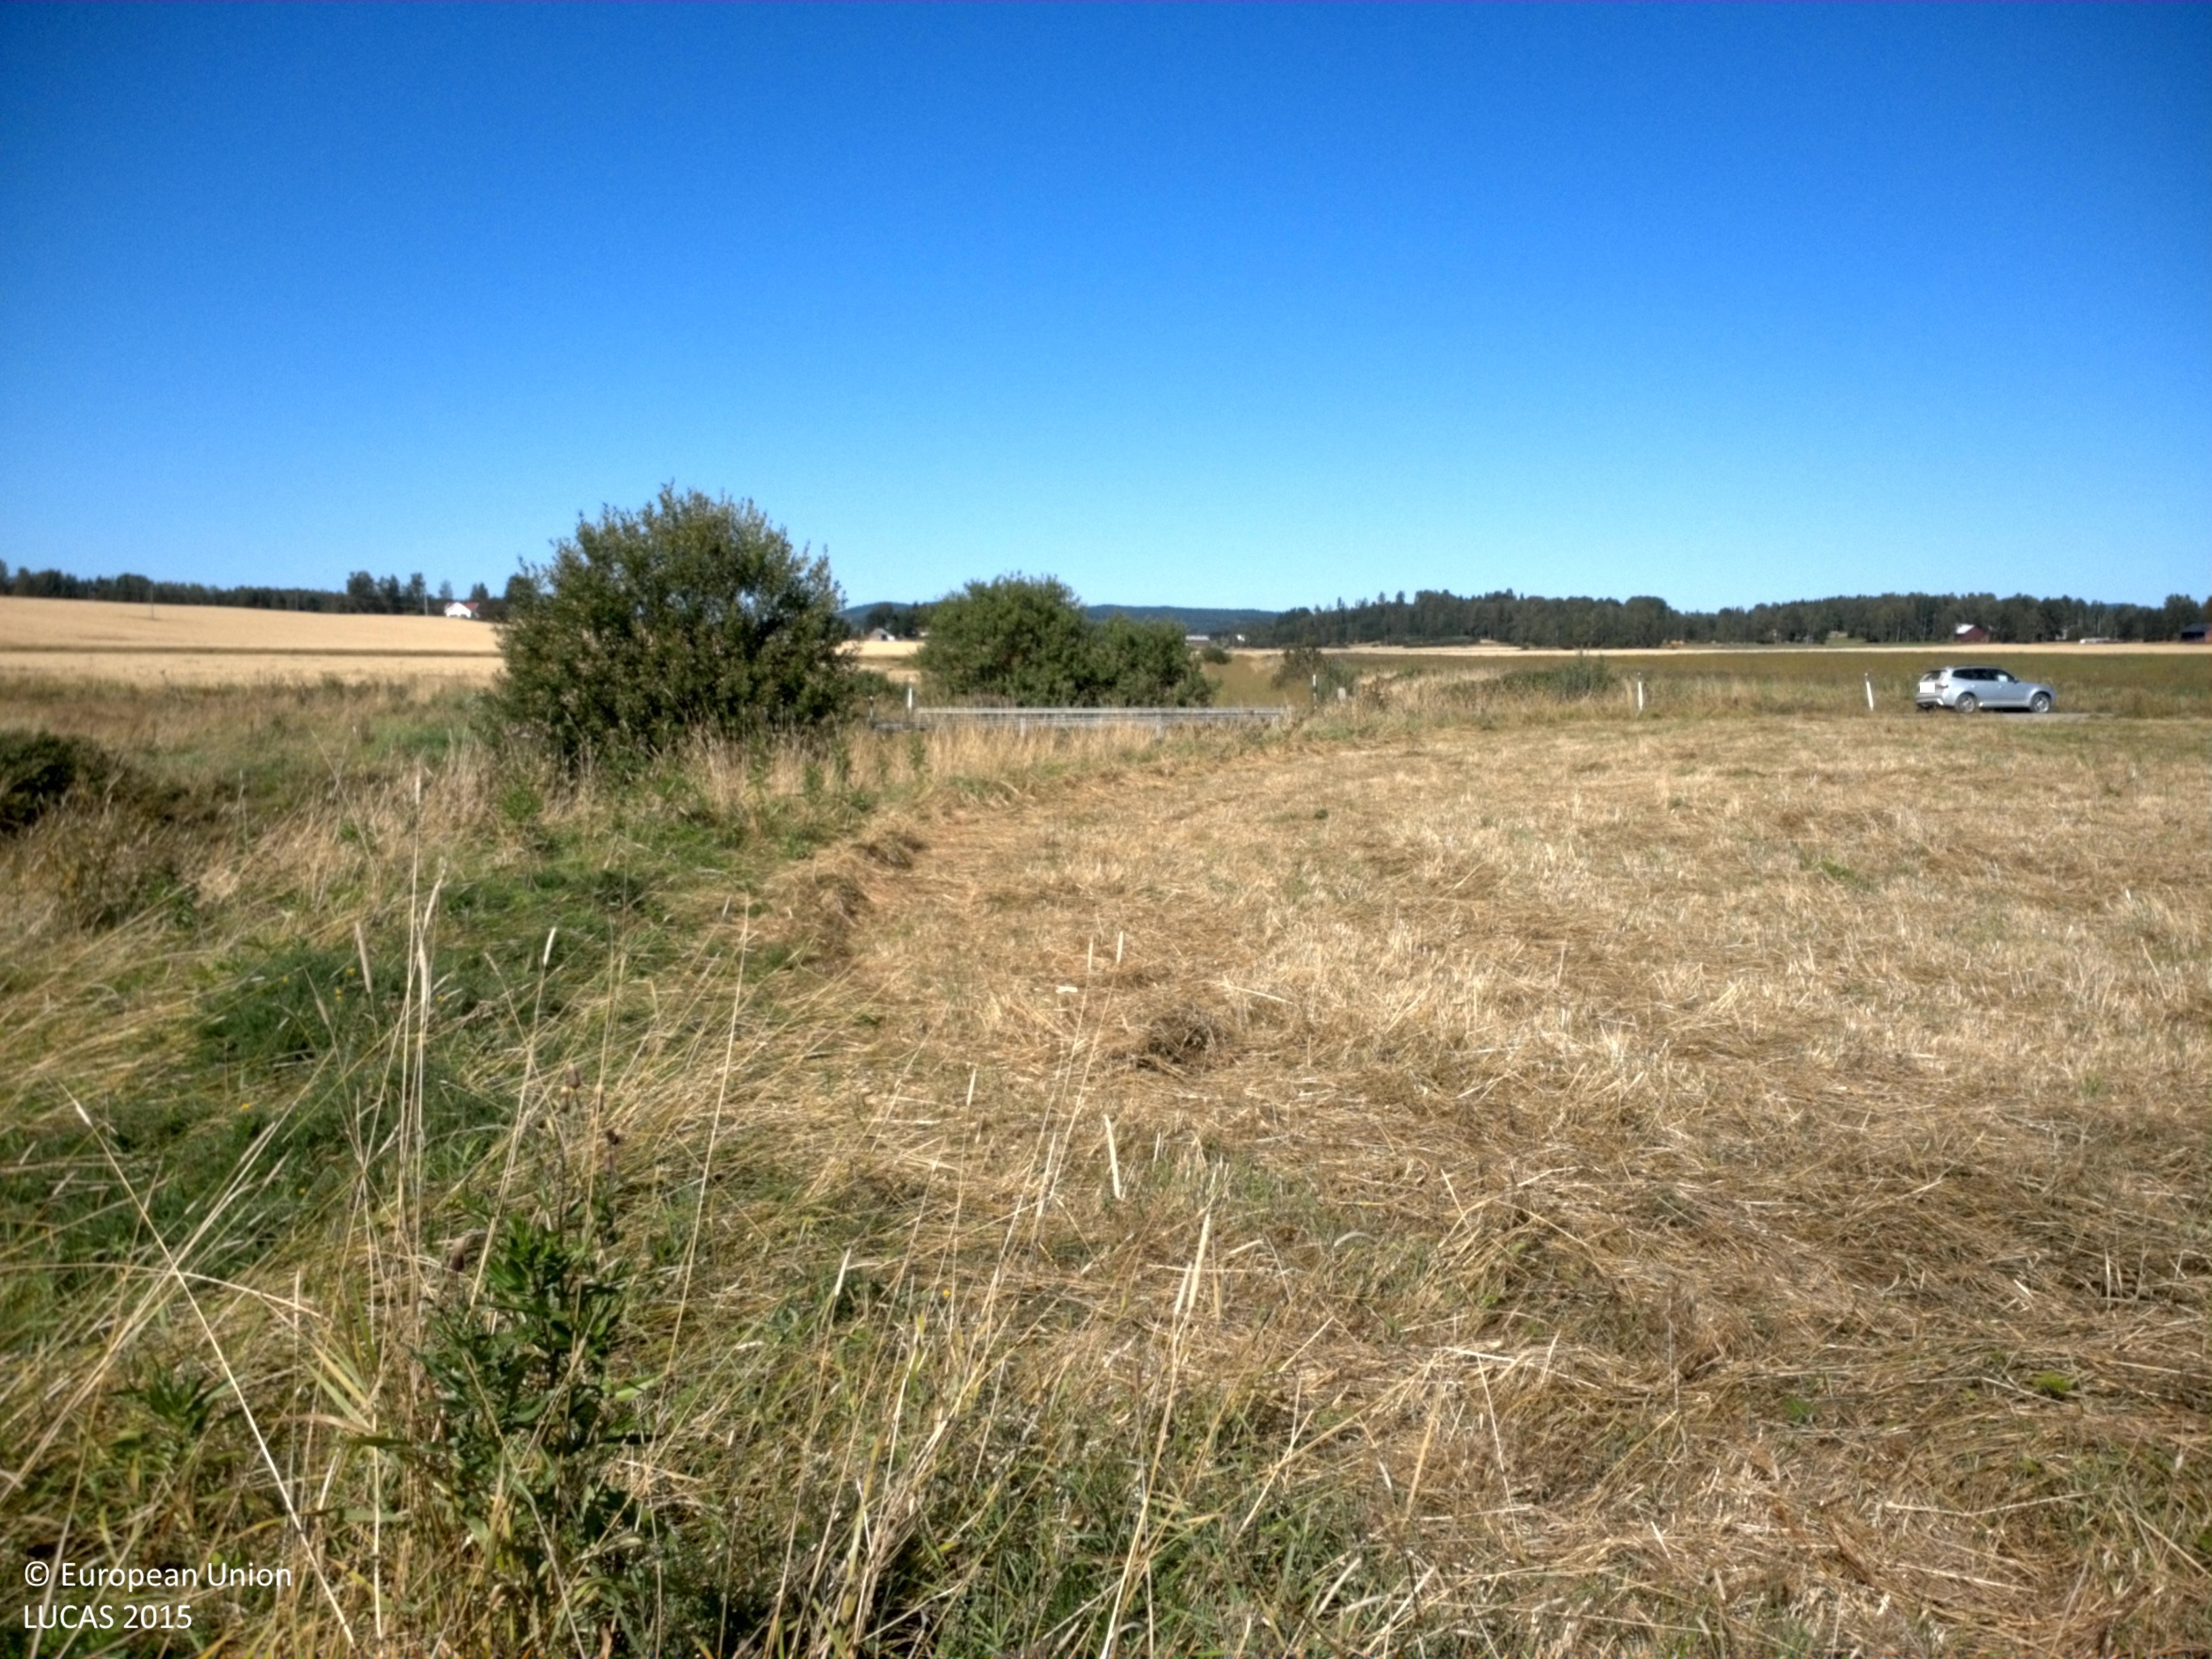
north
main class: Grassland
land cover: Grassland without tree/shrub cover
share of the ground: > 75 %
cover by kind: herbaceous plants 95 %, consolidated bare surface 5 %
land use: Agriculture (excluding fallow land and kitchen gardens)
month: August
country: SE
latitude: 59.8744
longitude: 13.1890
